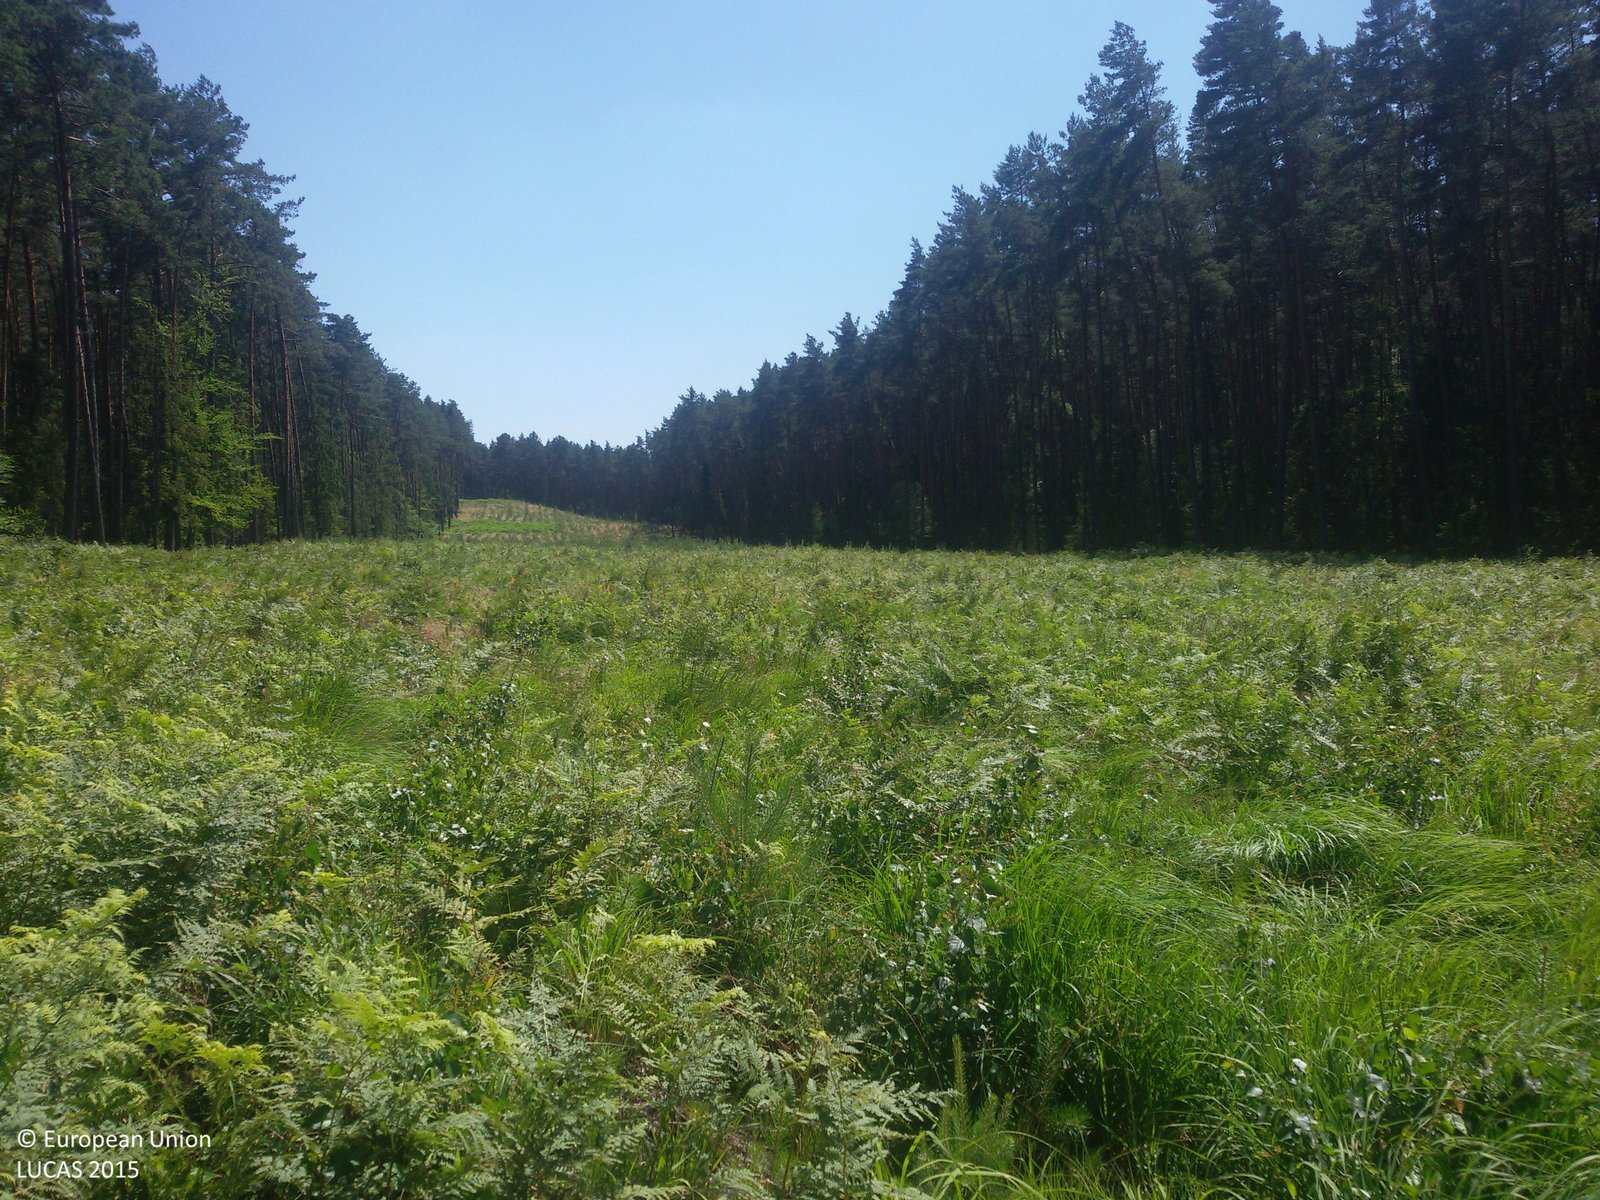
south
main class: Grassland
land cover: Spontaneously vegetated surfaces
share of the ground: > 75 %
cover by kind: herbaceous plants 100 %
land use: Forestry
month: July
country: PL
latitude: 50.5592
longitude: 17.6503
